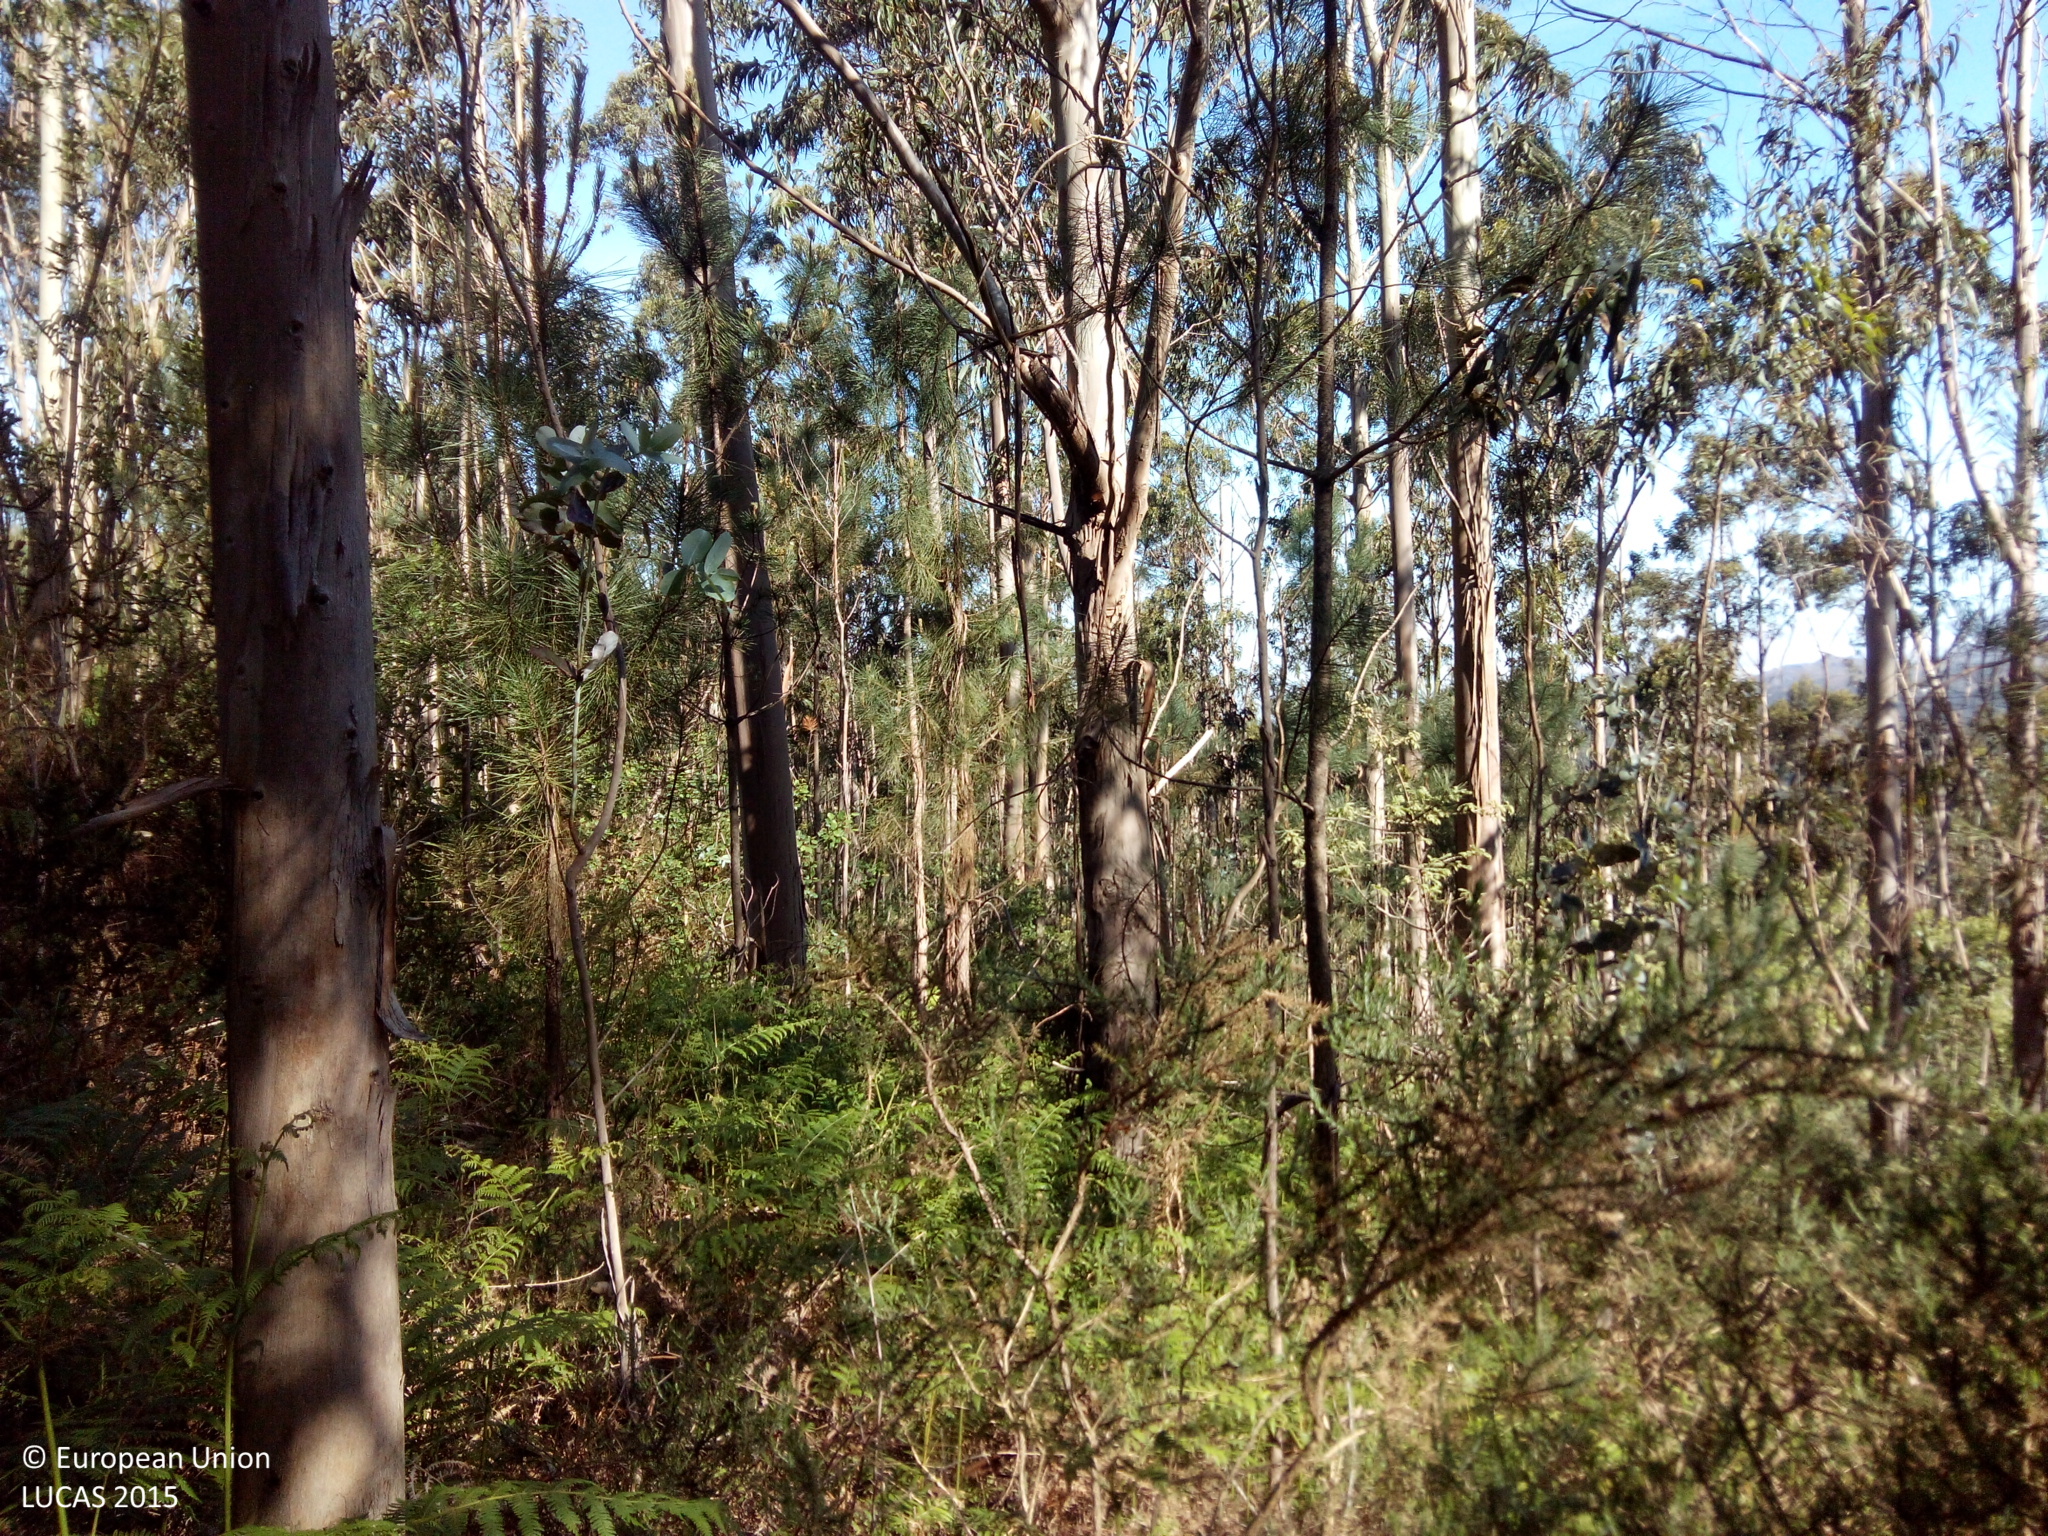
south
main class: Woodland
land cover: Broadleaved woodland
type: exotic forest
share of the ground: > 75 %
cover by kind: broadleaved forest trees 100 %
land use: Forestry
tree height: > 5 m
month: May
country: ES
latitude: 42.5948
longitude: -8.9928
